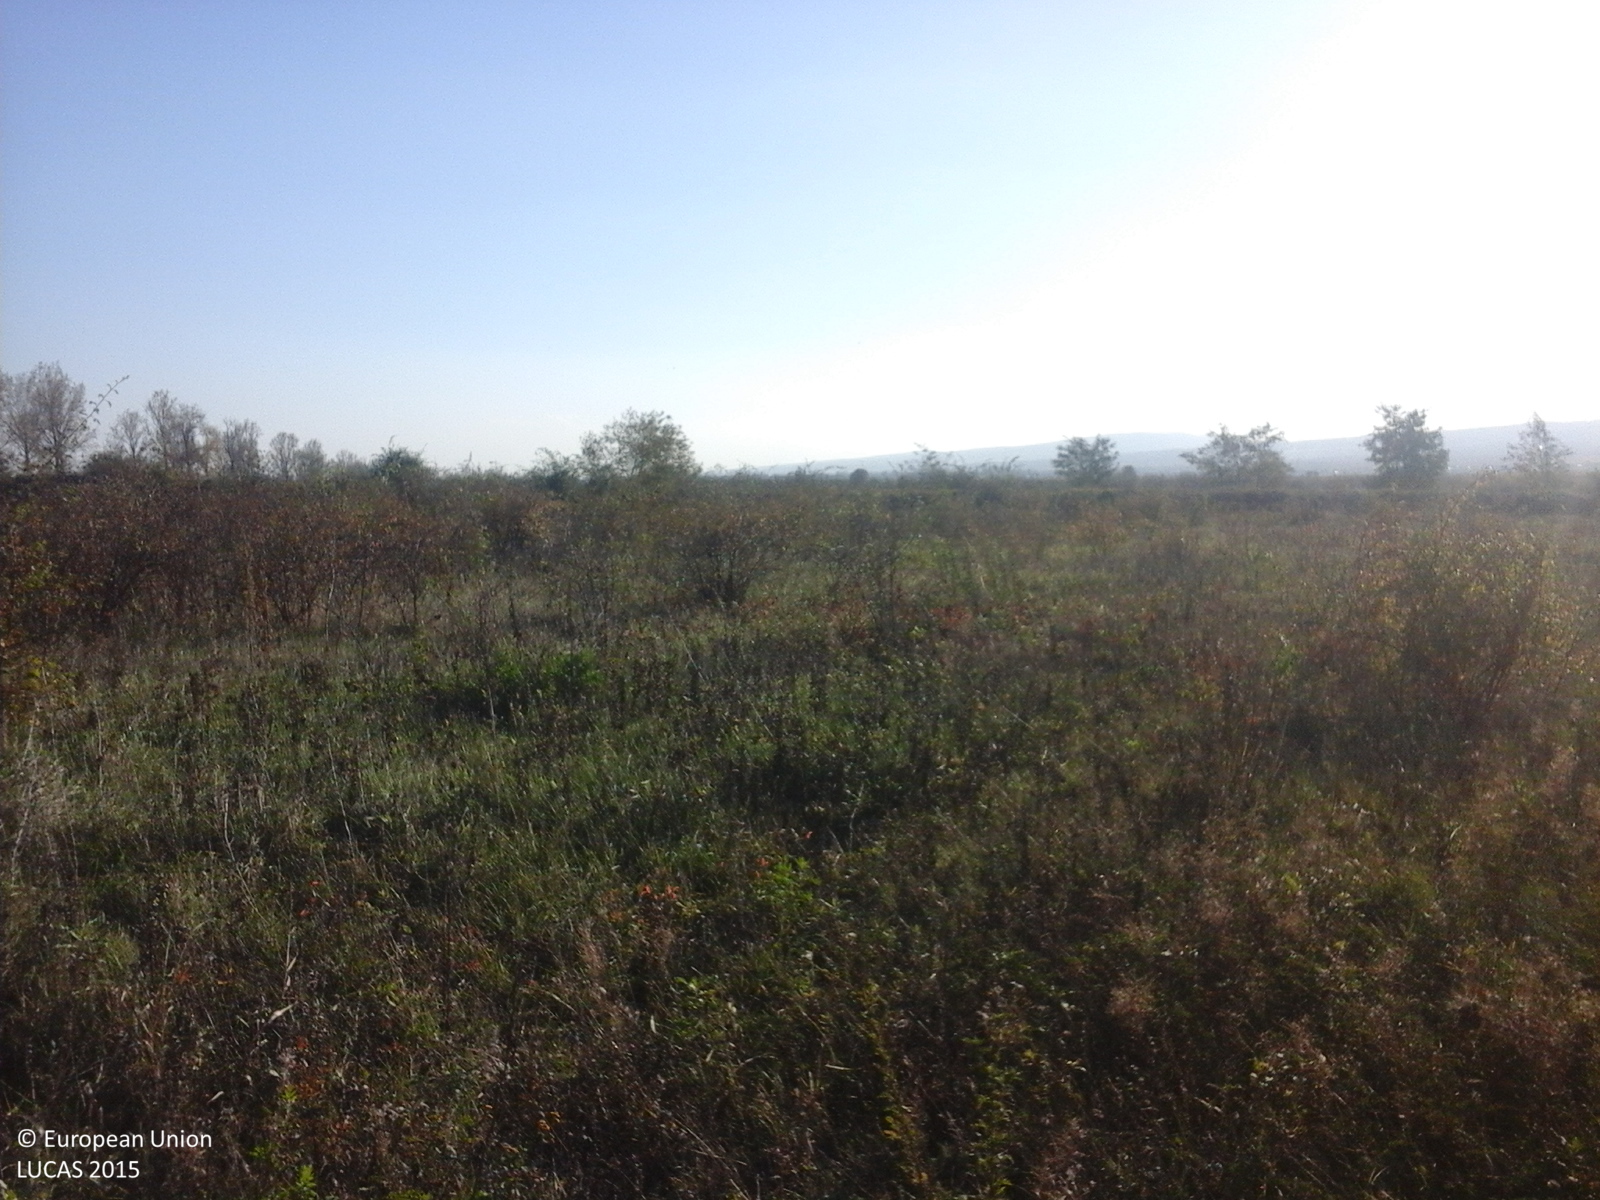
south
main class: Grassland
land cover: Spontaneously vegetated surfaces
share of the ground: > 75 %
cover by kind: herbaceous plants 100 %
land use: Fallow land
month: October
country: RO
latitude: 45.8301
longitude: 27.0723
